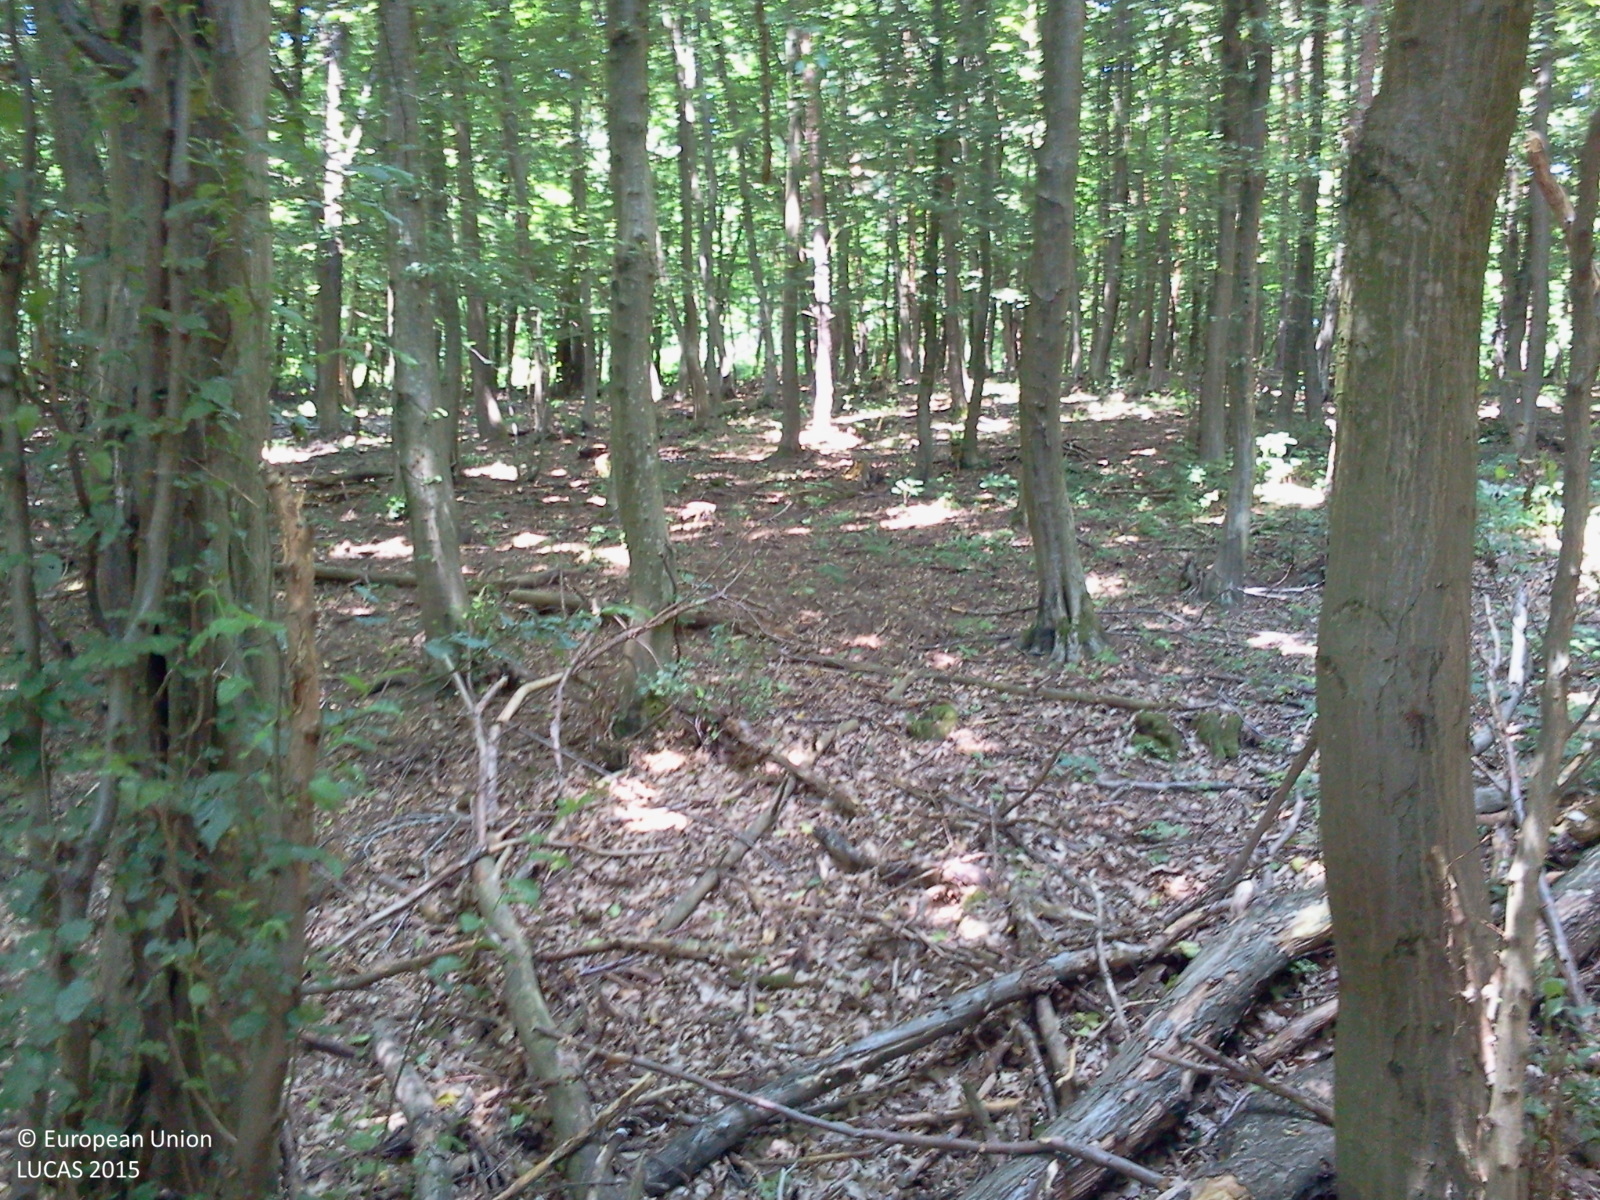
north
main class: Woodland
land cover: Broadleaved woodland
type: thermophilous deciduous forest
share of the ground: > 75 %
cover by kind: broadleaved forest trees 95 %, unconsolidated bare surface 5 %
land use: Forestry
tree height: > 5 m
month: June
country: HU
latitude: 46.8434
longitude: 17.0194
